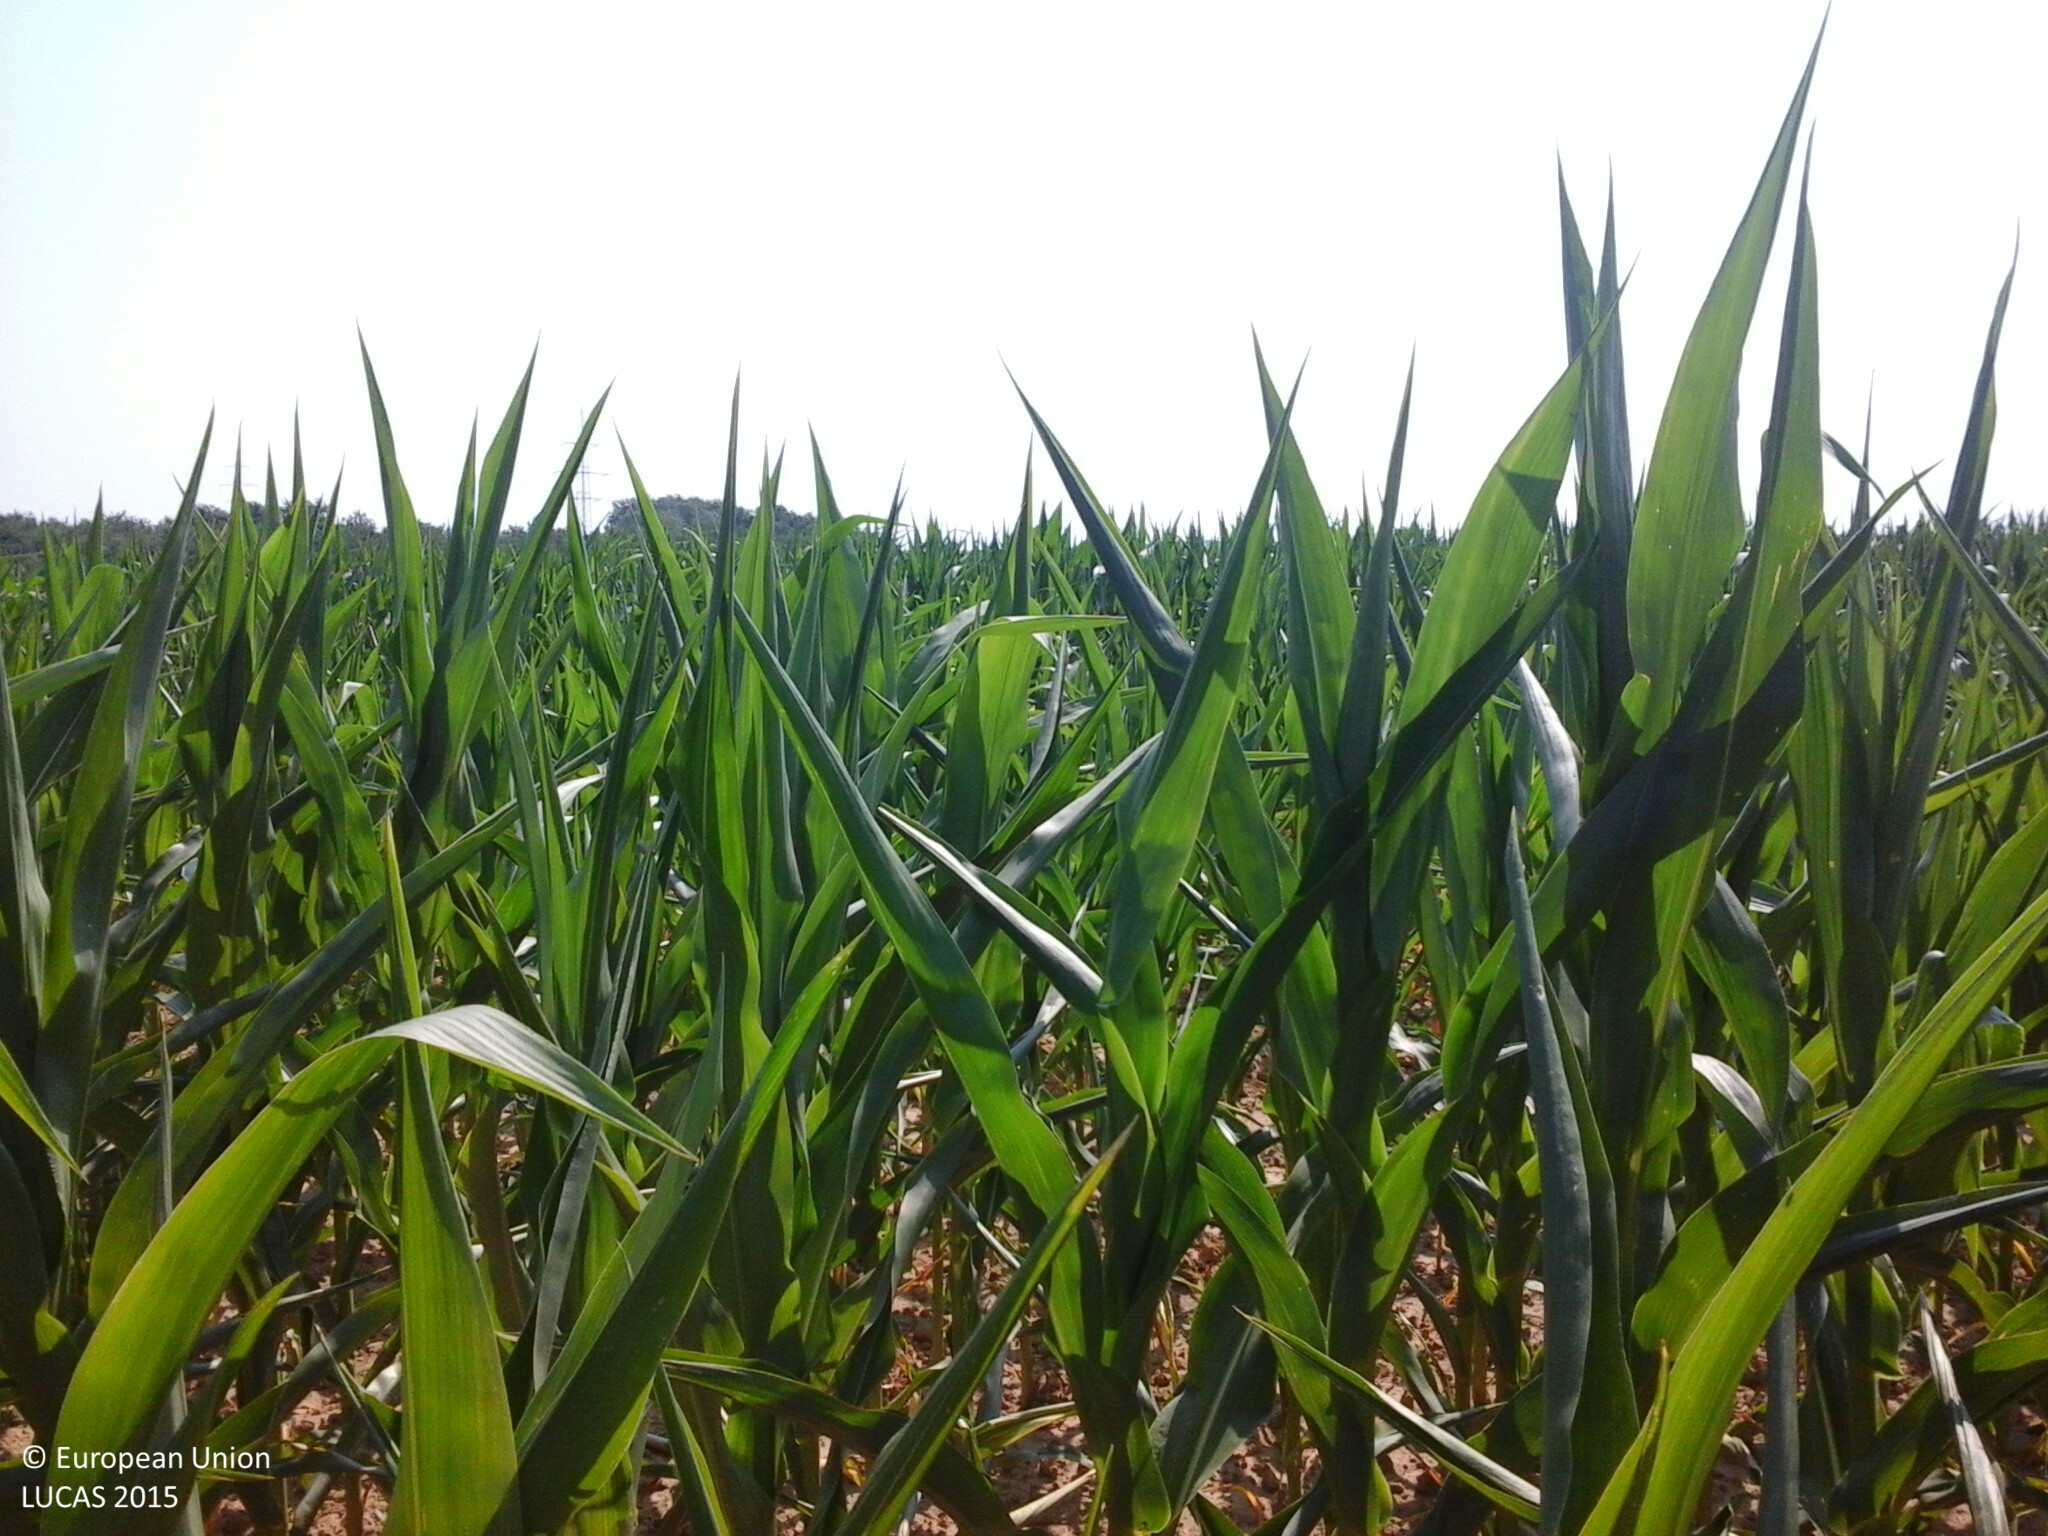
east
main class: Cropland
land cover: Maize
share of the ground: 50 - 75 %
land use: Agriculture (excluding fallow land and kitchen gardens)
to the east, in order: Maize; Sunflower
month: July
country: HU
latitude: 48.2920
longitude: 22.1732
